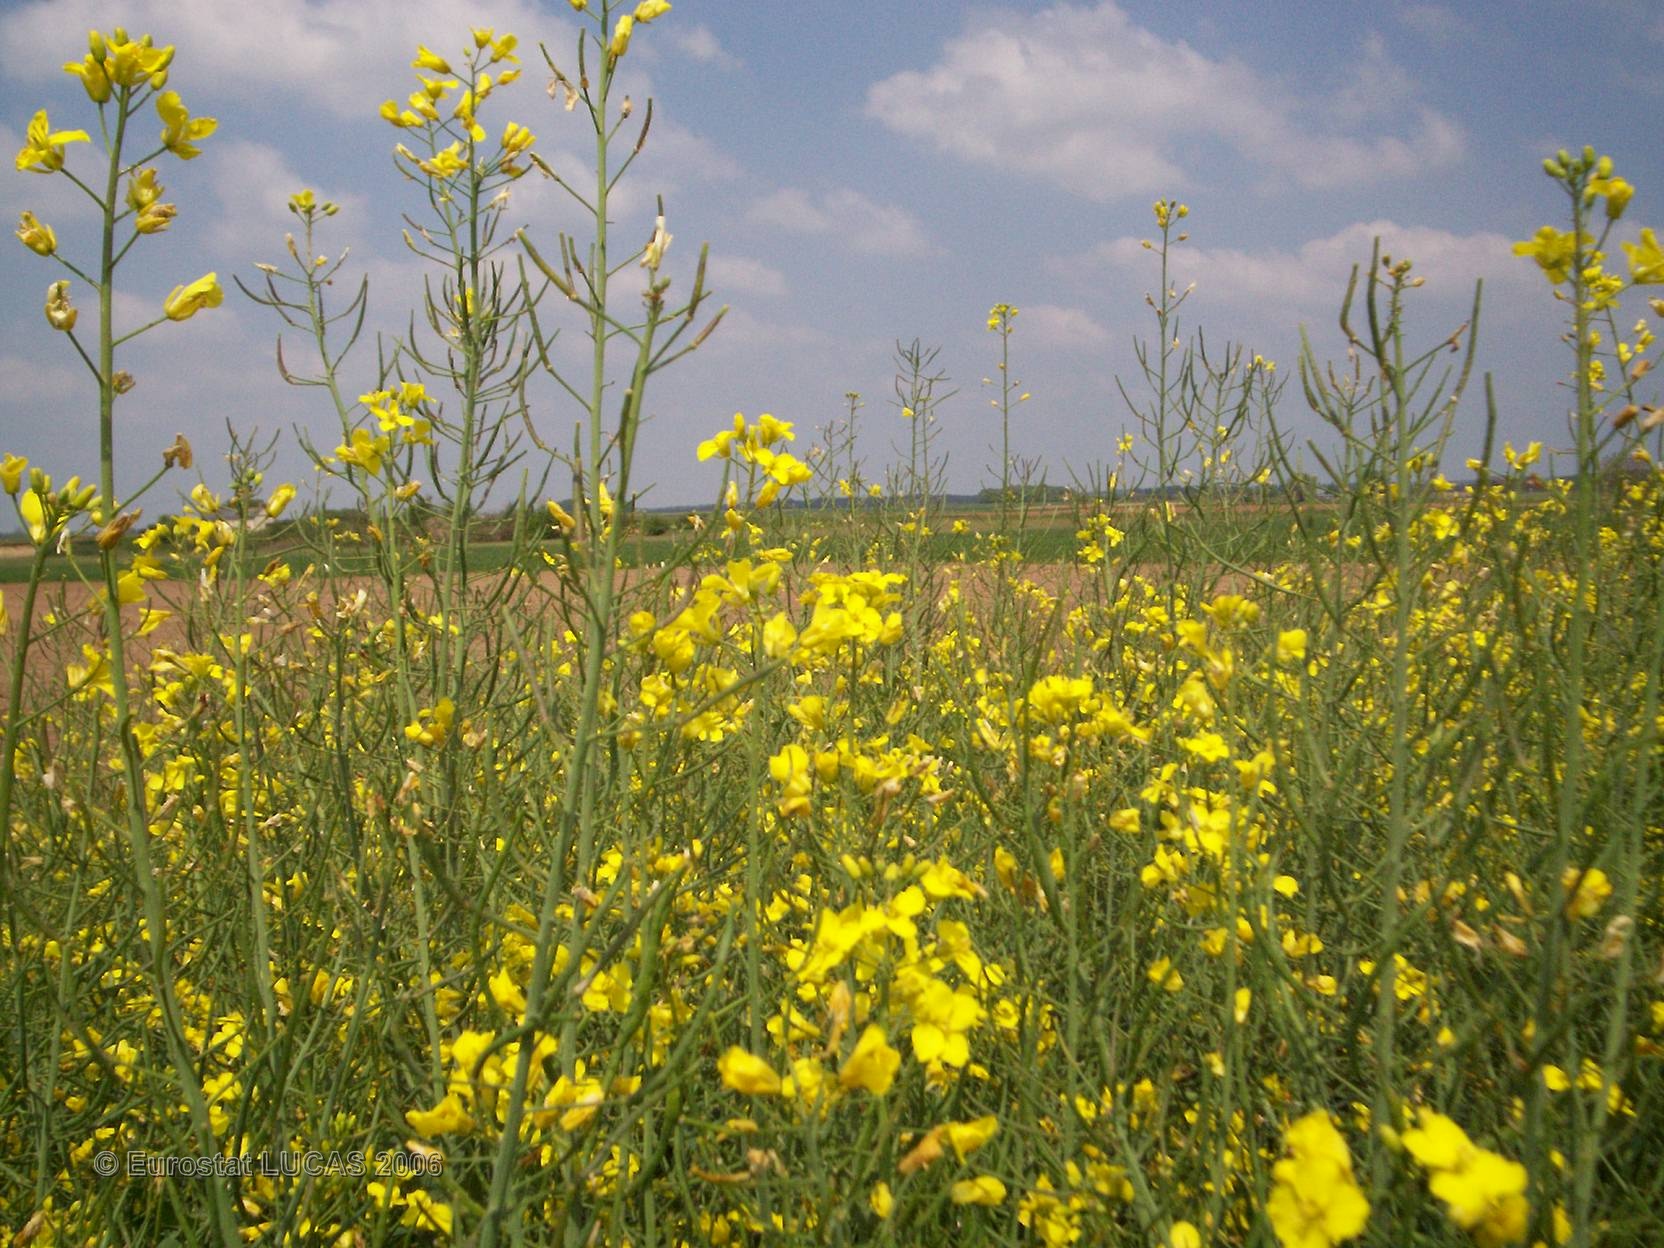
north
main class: Cropland
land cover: Rape and turnip rape
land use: Agriculture (excluding fallow land and kitchen gardens)
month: May
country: FR
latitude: 47.4976
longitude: 0.2192
